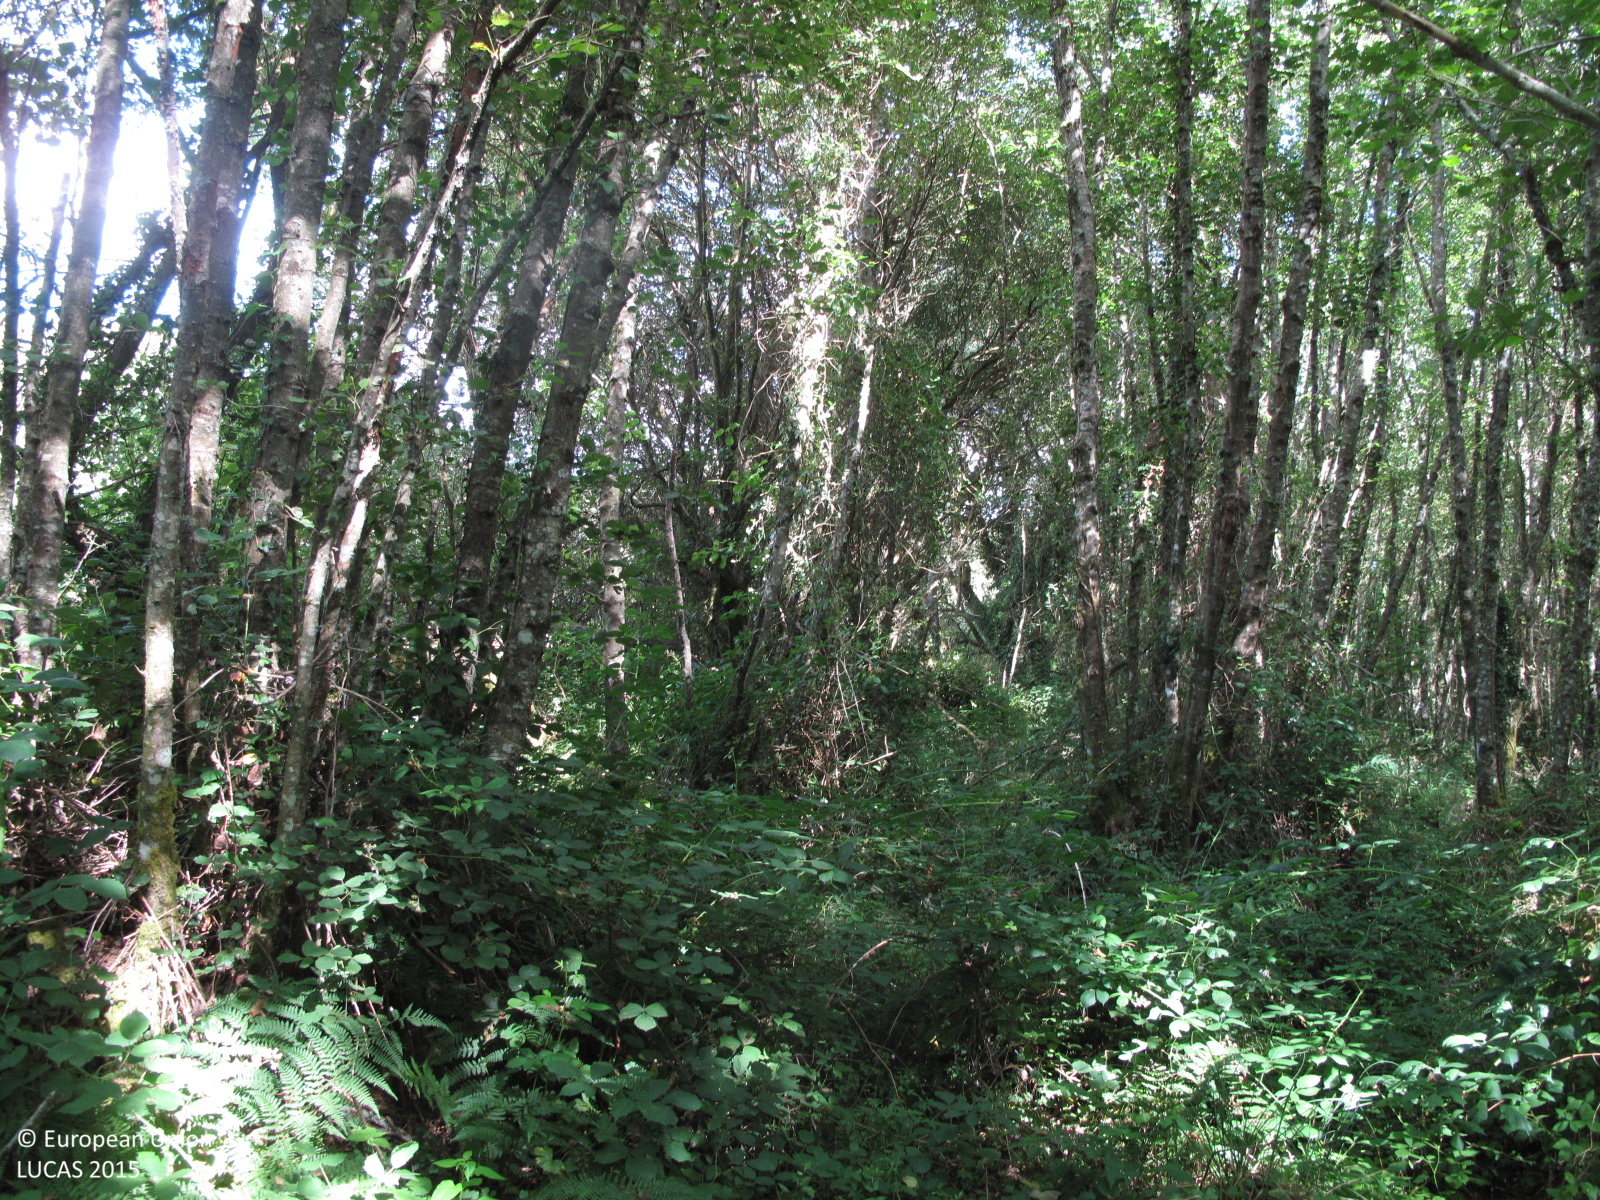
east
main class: Woodland
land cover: Broadleaved woodland
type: floodplain forest
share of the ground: > 75 %
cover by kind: broadleaved forest trees 90 %, shrubs 5 %, herbaceous plants 5 %
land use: Semi-natural and natural areas not in use
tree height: > 5 m
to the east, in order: Broadleaved woodland; Grassland without tree/shrub cover; Broadleaved woodland; Grassland without tree/shrub cover; Broadleaved woodland; Grassland without tree/shrub cover; Broadleaved woodland; Rivers and streams; Broadleaved woodland
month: July
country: ES
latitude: 43.0592
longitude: -7.9798
